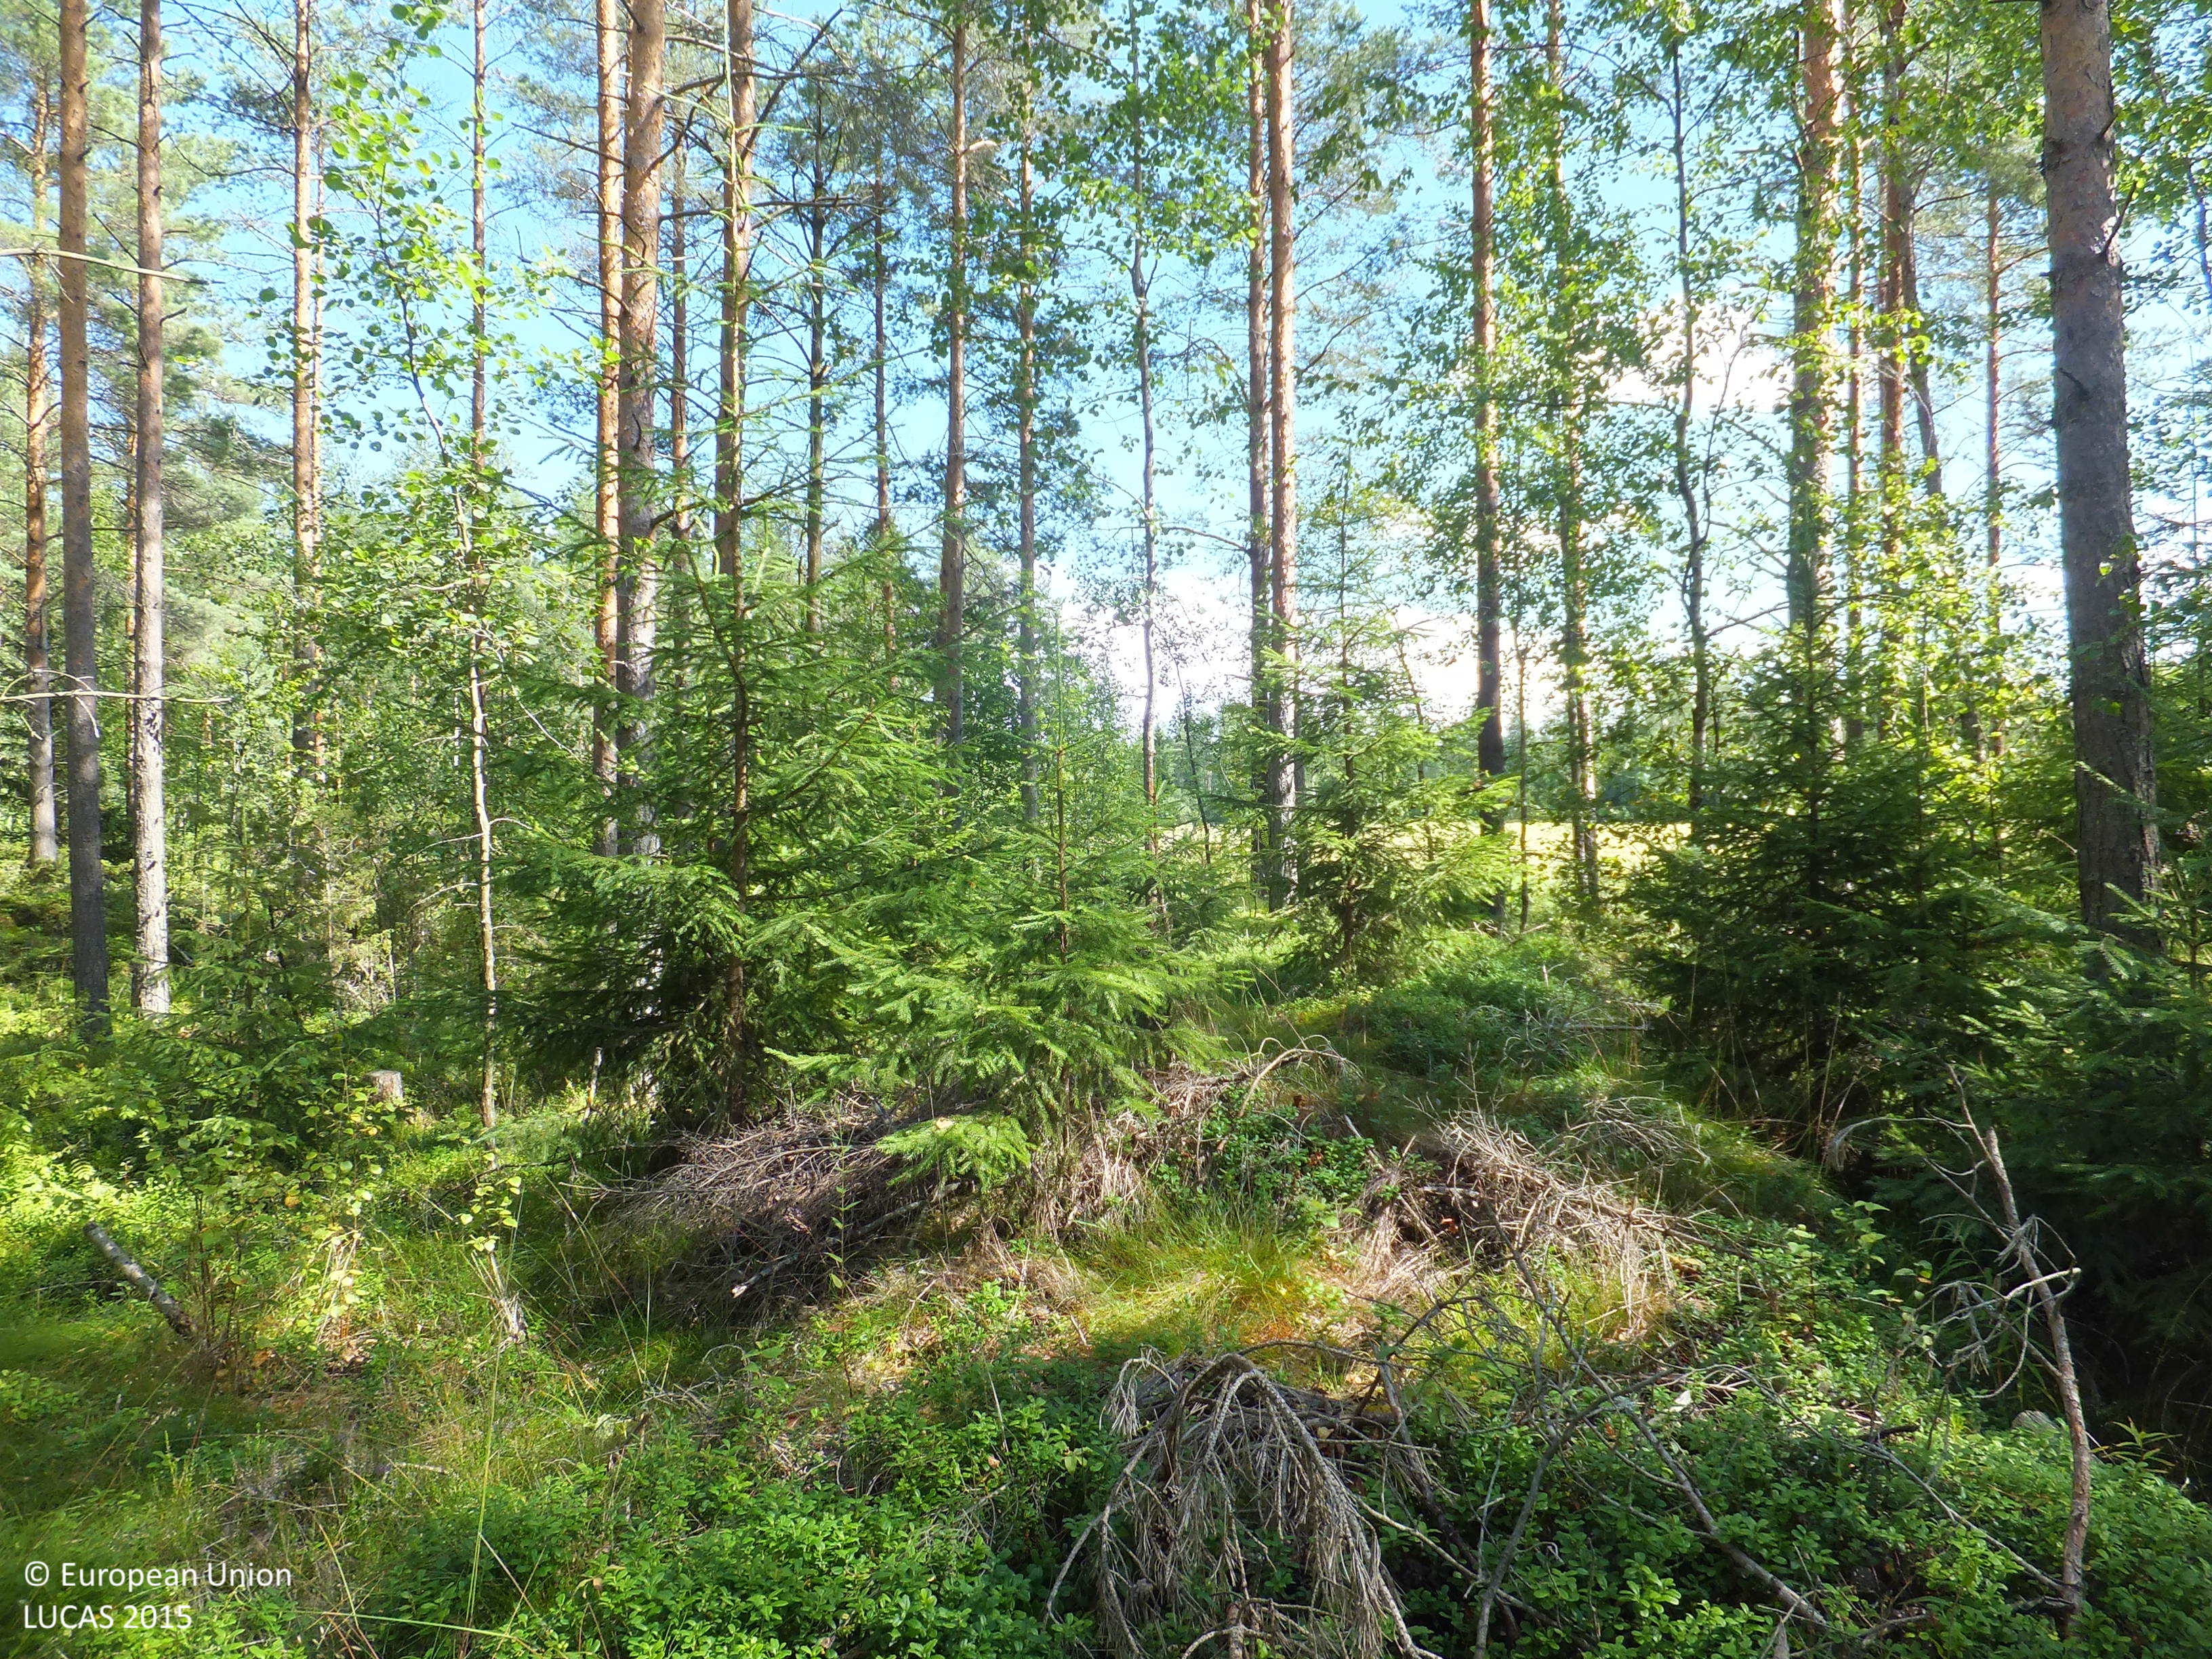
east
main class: Woodland
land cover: Pine dominated mixed woodland
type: boreal forest
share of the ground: 50 - 75 %
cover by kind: coniferous forest trees 40 %, shrubs 20 %, broadleaved forest trees 15 %, herbaceous plants 10 %, lichens and mosses 10 %, consolidated bare surface 5 %
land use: Forestry
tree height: > 5 m
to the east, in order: Pine dominated mixed woodland; Ditches and canals; Grassland without tree/shrub cover; Tracks; Grassland without tree/shrub cover; Barley; Ditches and canals; Other mixed woodland
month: August
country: FI
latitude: 63.0788
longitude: 22.7040
